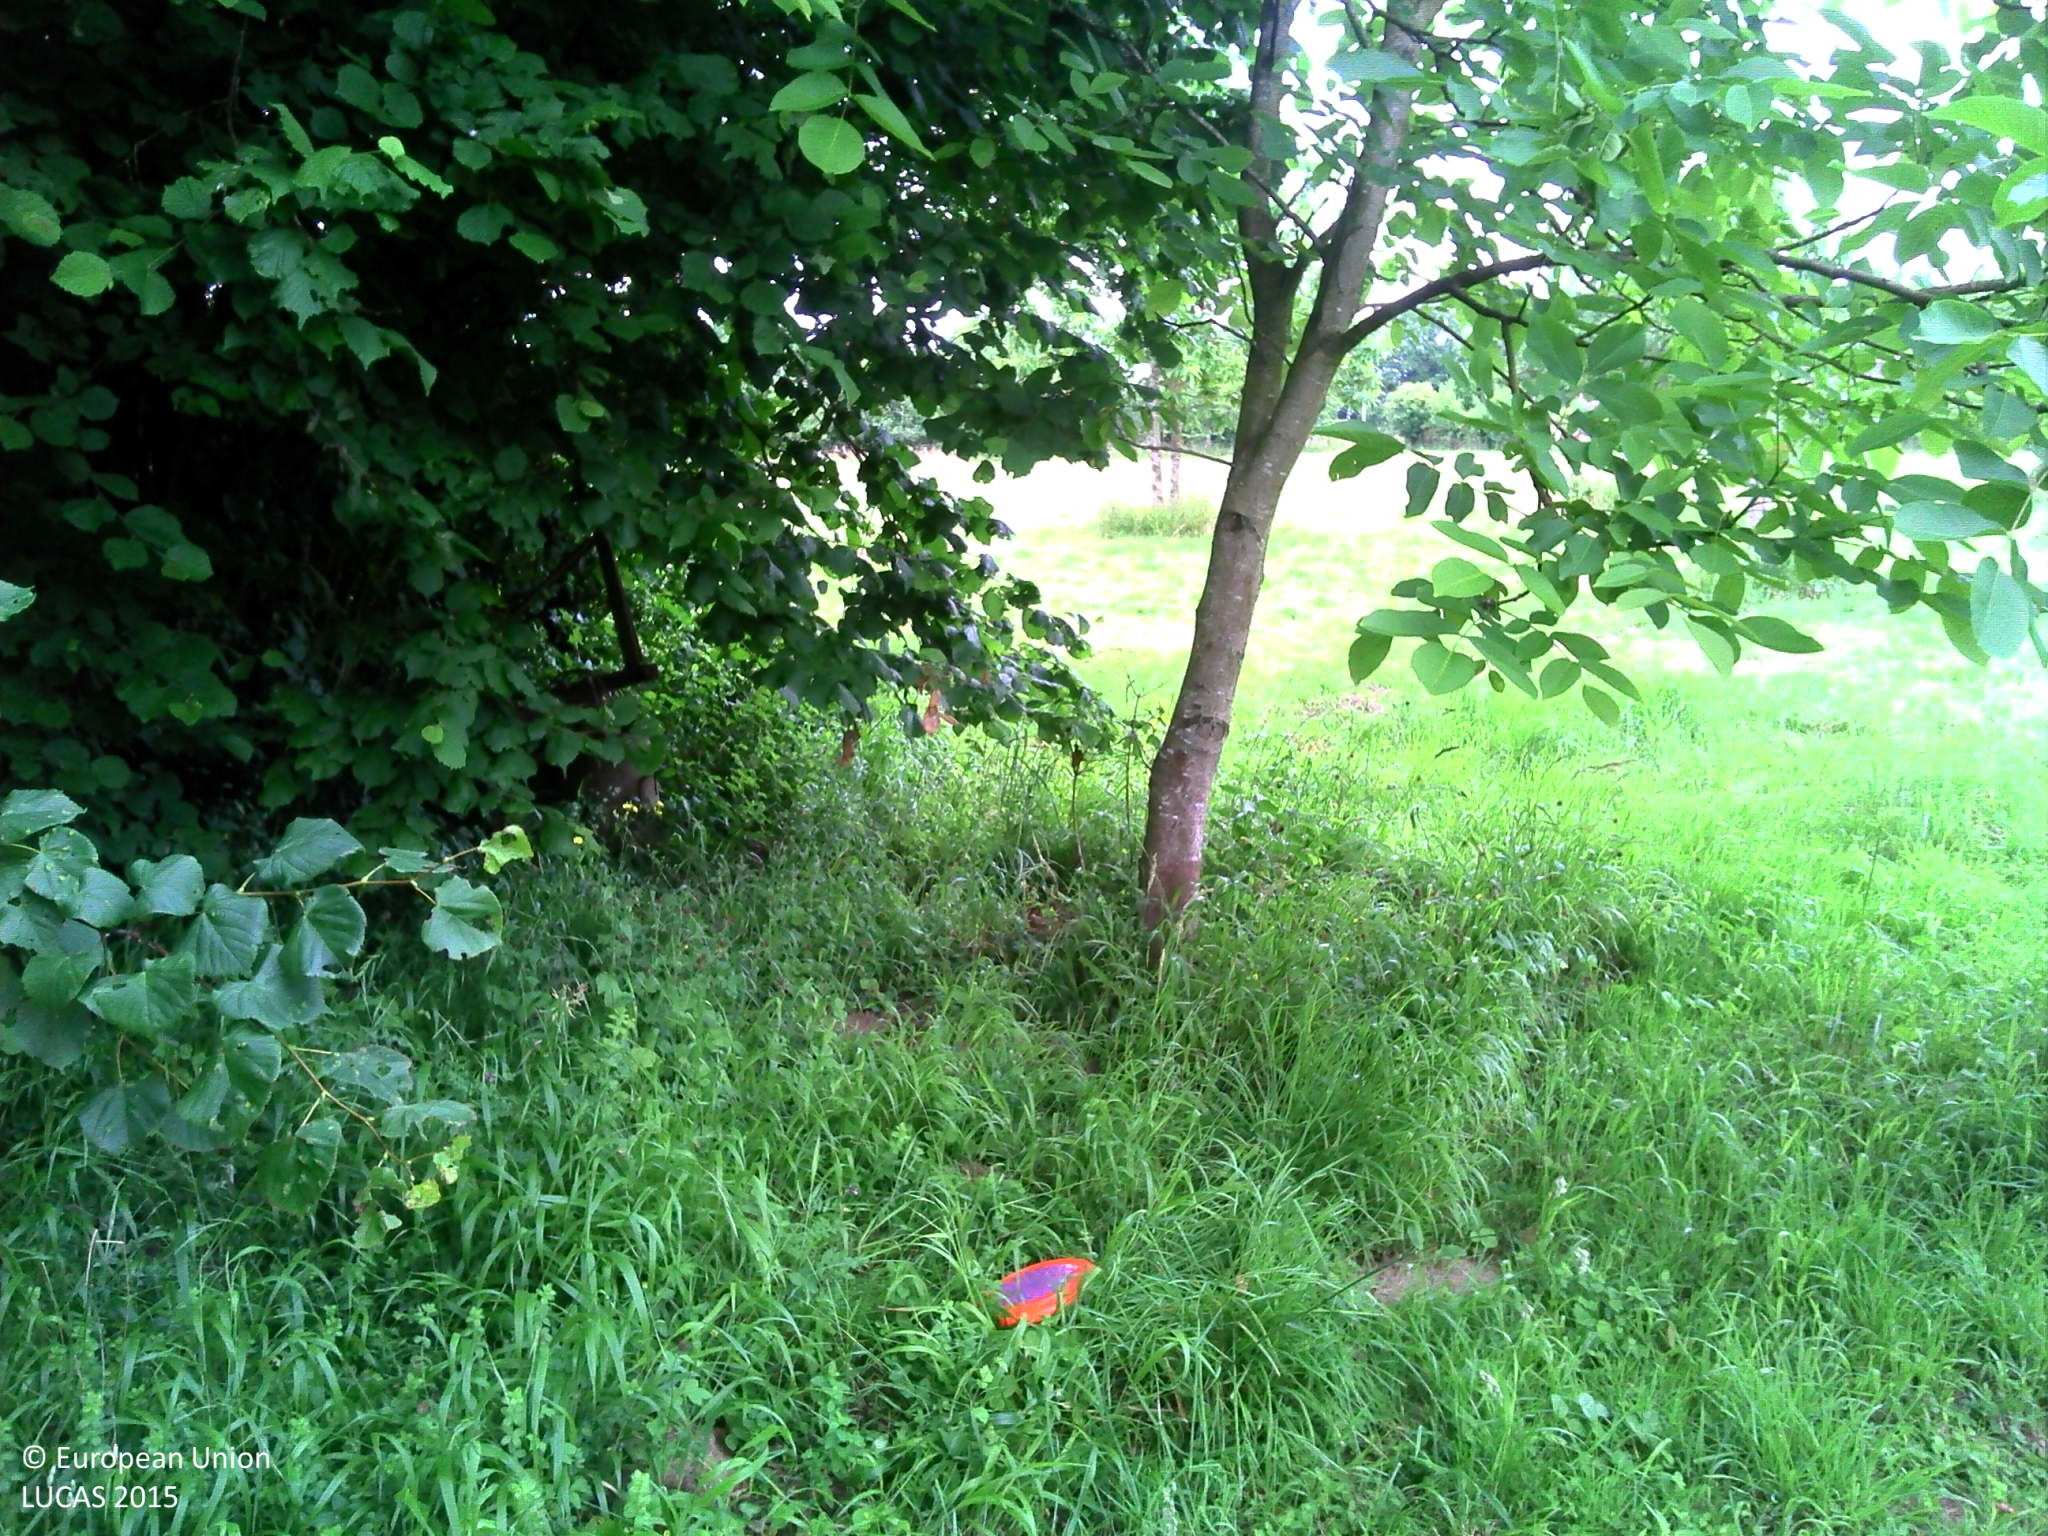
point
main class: Grassland
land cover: Grassland with sparse tree/shrub cover
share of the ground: > 75 %
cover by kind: herbaceous plants 95 %, broadleaved forest trees 5 %
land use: Agriculture (excluding fallow land and kitchen gardens)
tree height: > 5 m
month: June
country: FR
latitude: 48.0417
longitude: 0.2225
